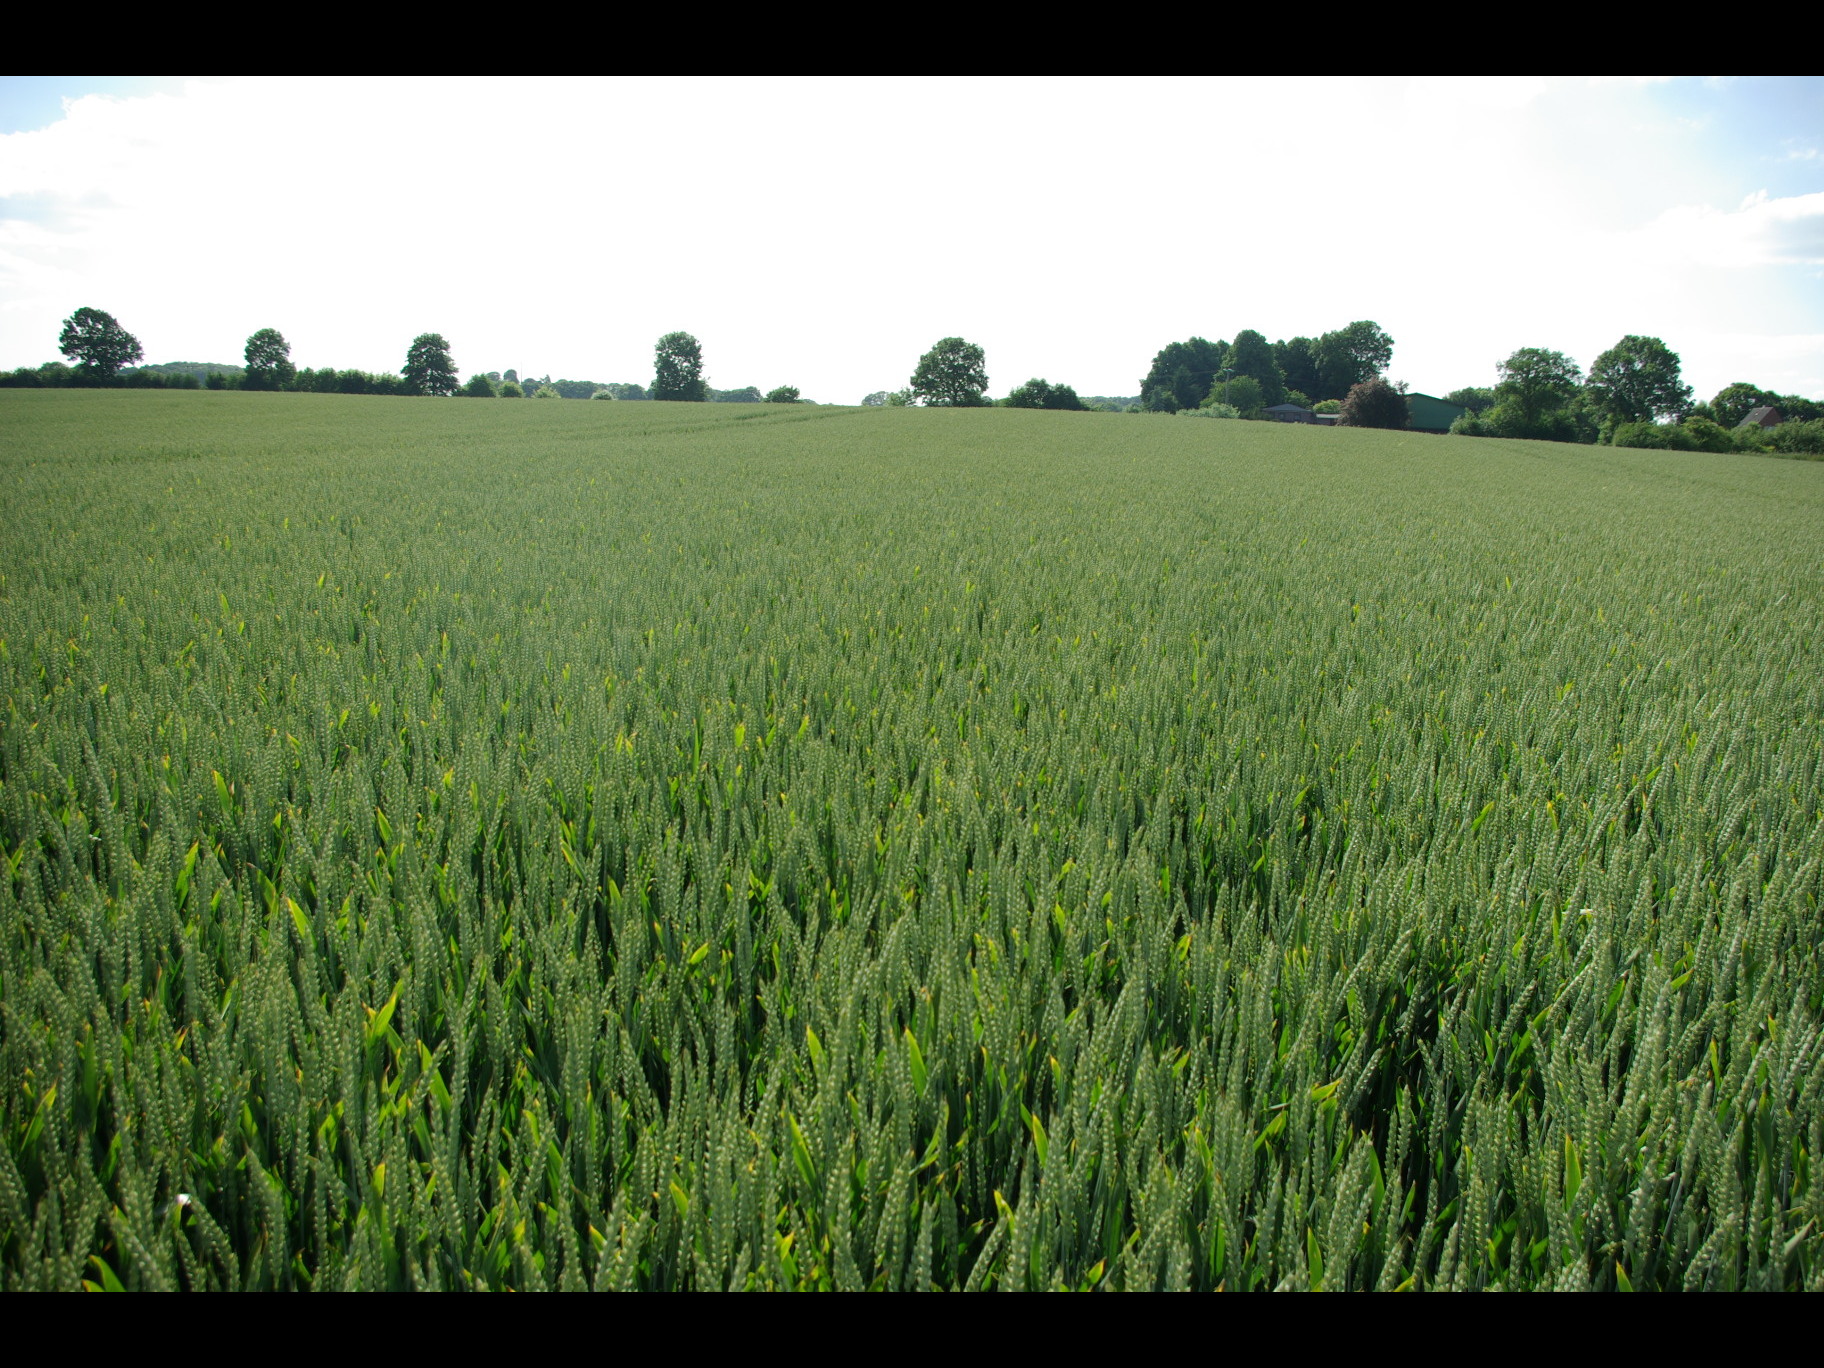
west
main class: Cropland
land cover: Common wheat
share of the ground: > 75 %
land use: Agriculture (excluding fallow land and kitchen gardens)
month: June
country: DE
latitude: 54.3004
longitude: 9.8311
